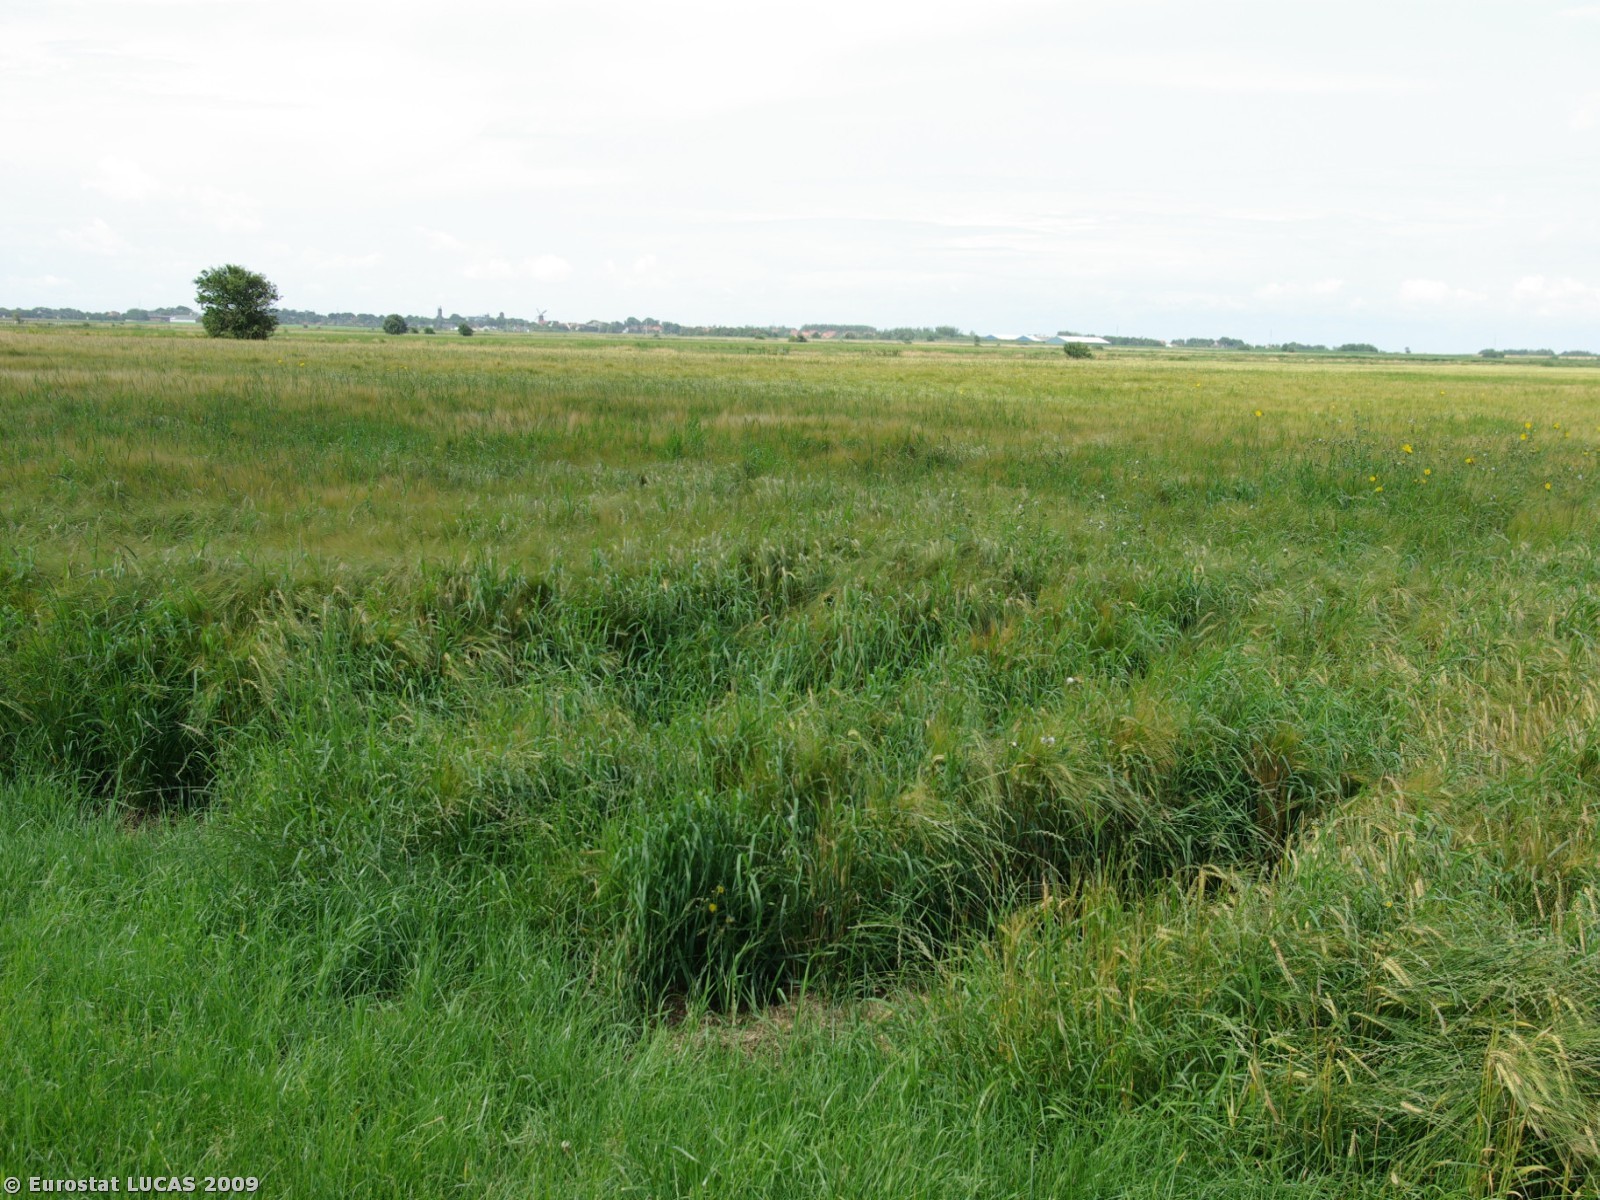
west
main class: Grassland
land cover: Grassland without tree/shrub cover
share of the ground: > 75 %
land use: Agriculture (excluding fallow land and kitchen gardens)
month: July
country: DK
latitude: 54.9771
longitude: 8.7354
